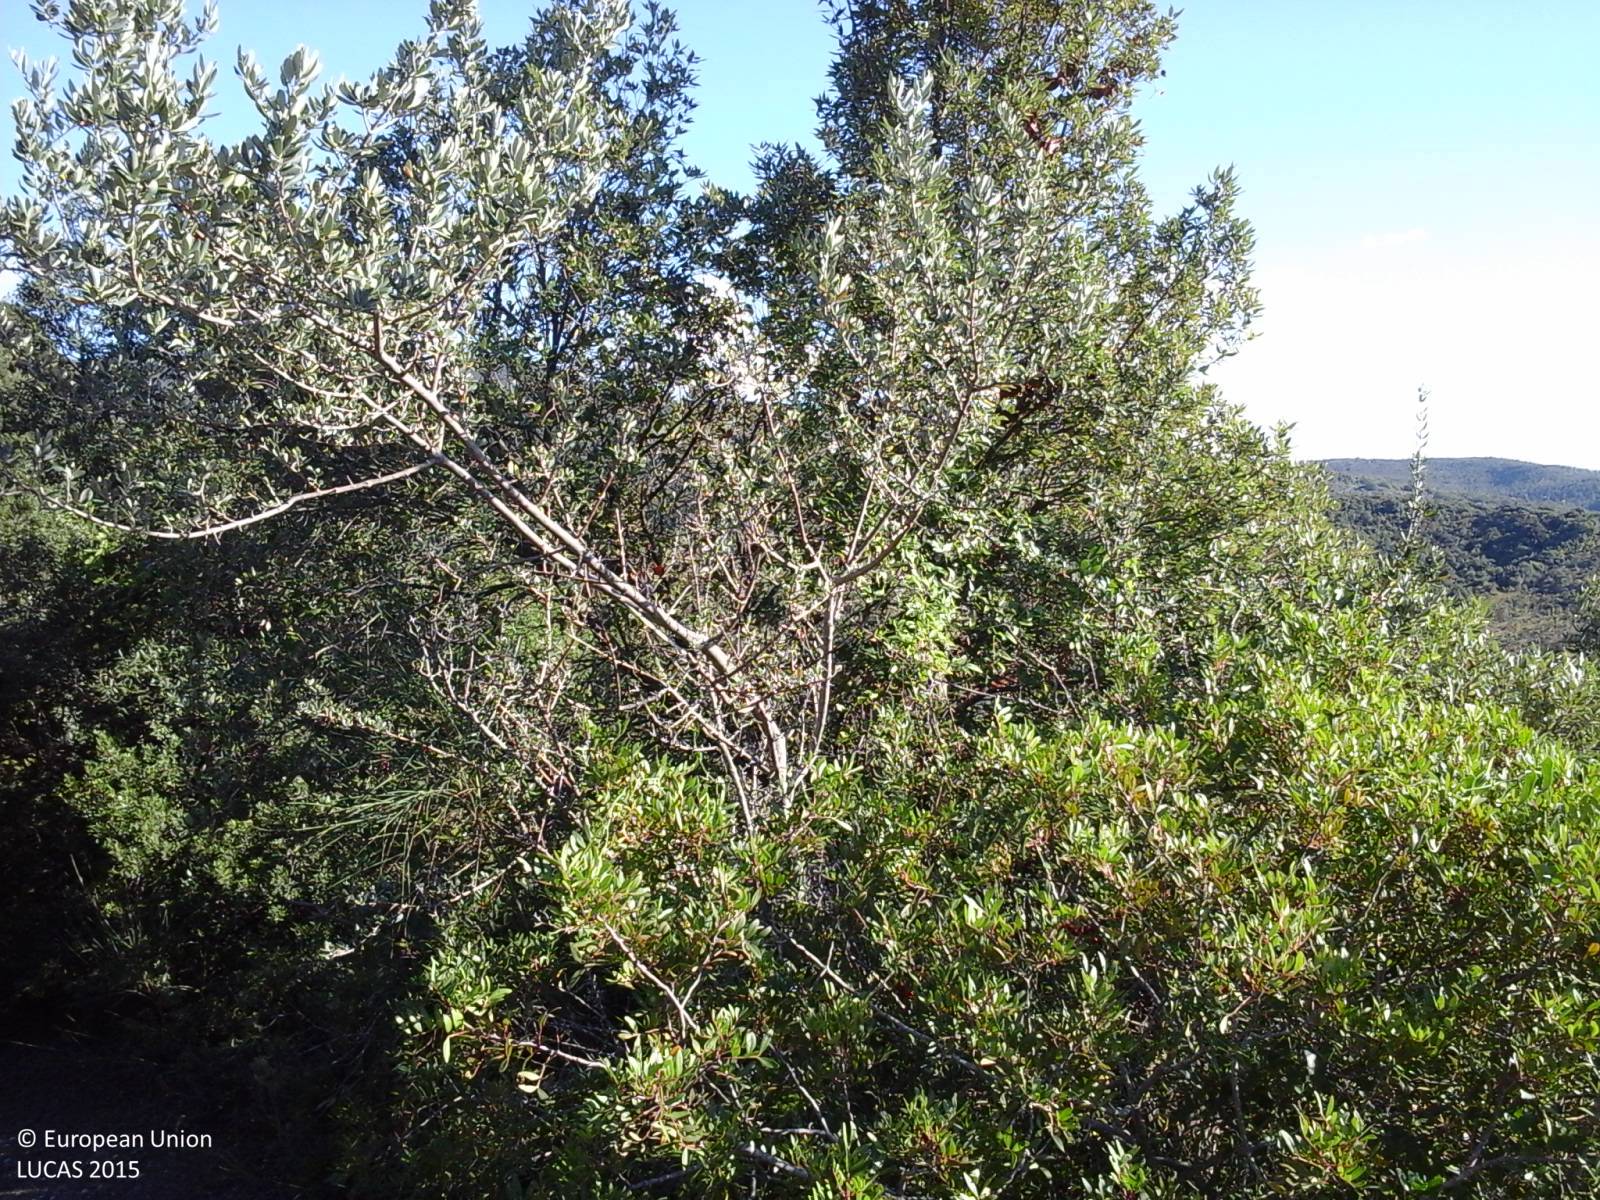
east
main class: Woodland
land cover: Broadleaved woodland
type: thermophilous deciduous forest
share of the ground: > 75 %
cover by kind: broadleaved forest trees 80 %, shrubs 20 %
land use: Forestry
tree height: > 5 m
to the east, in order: Broadleaved woodland
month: October
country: IT
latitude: 43.4108
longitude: 10.5541
